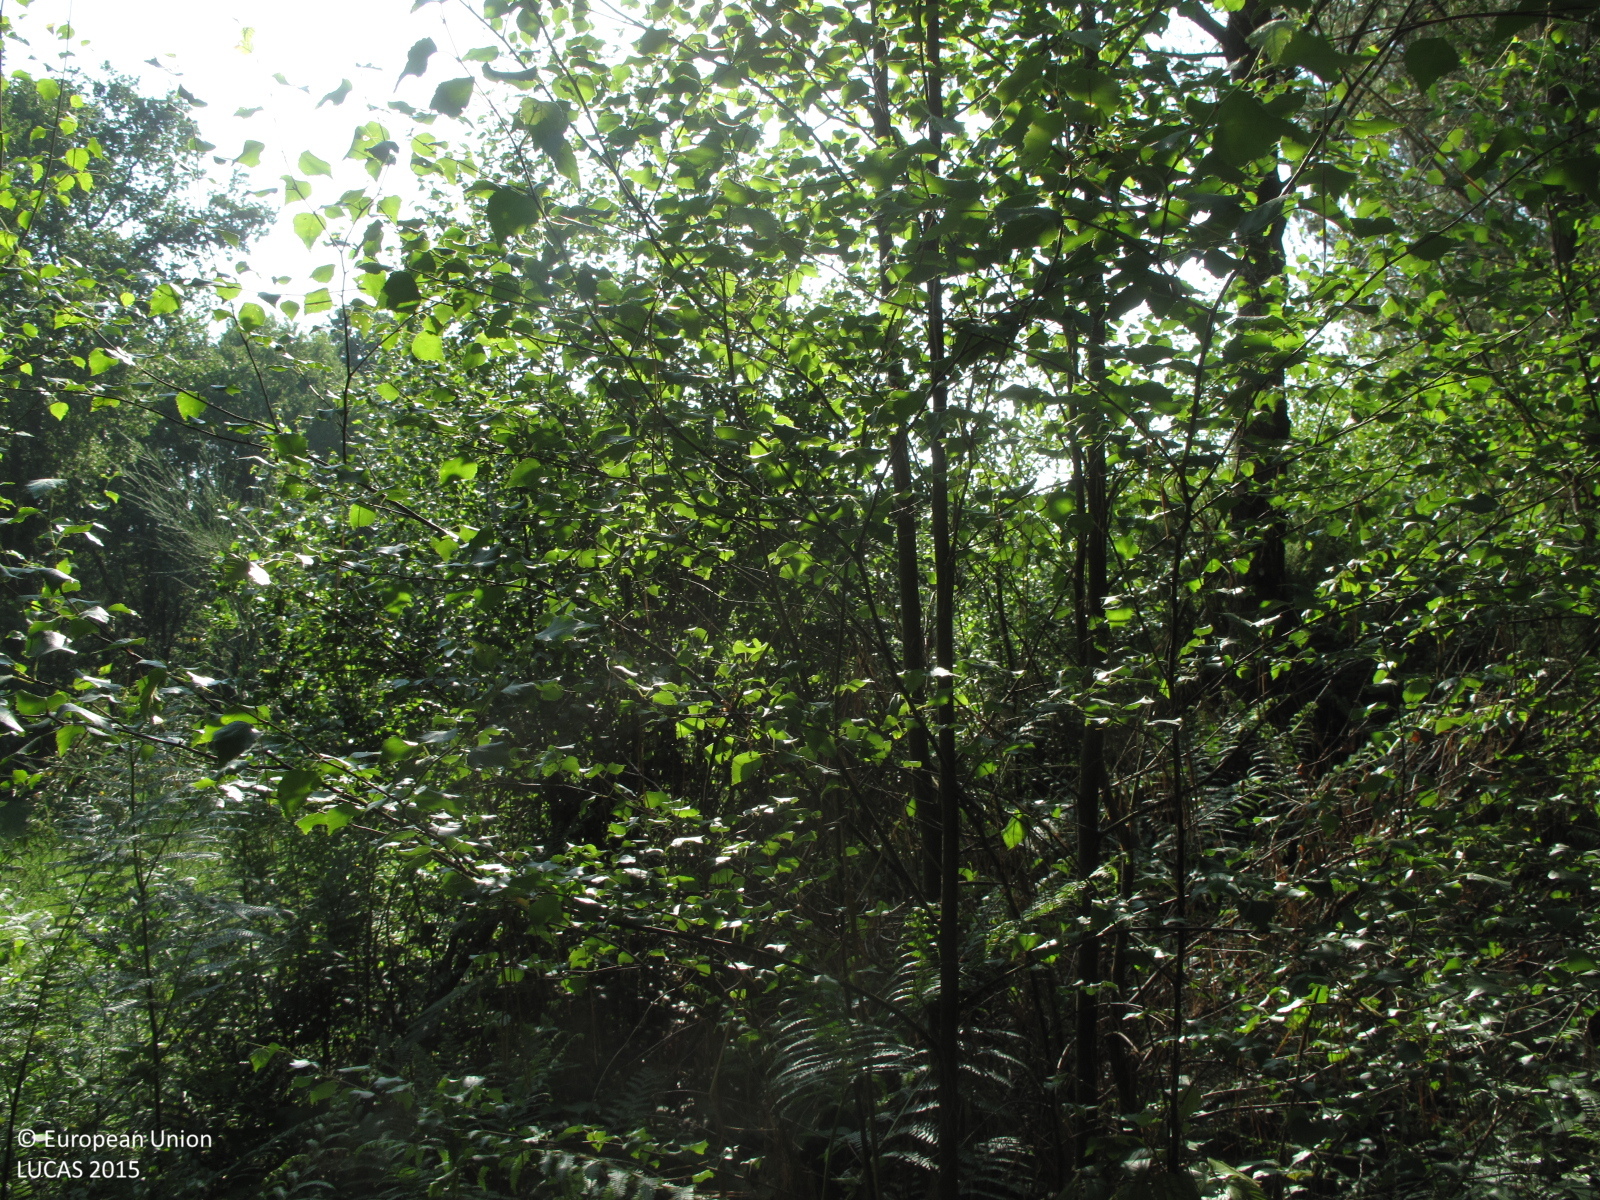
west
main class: Woodland
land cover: Pine dominated coniferous woodland
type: exotic forest
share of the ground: 50 - 75 %
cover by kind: coniferous forest trees 60 %, shrubs 20 %, broadleaved forest trees 10 %, herbaceous plants 10 %
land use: Forestry
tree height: > 5 m
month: June
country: ES
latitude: 43.0197
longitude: -7.8916
